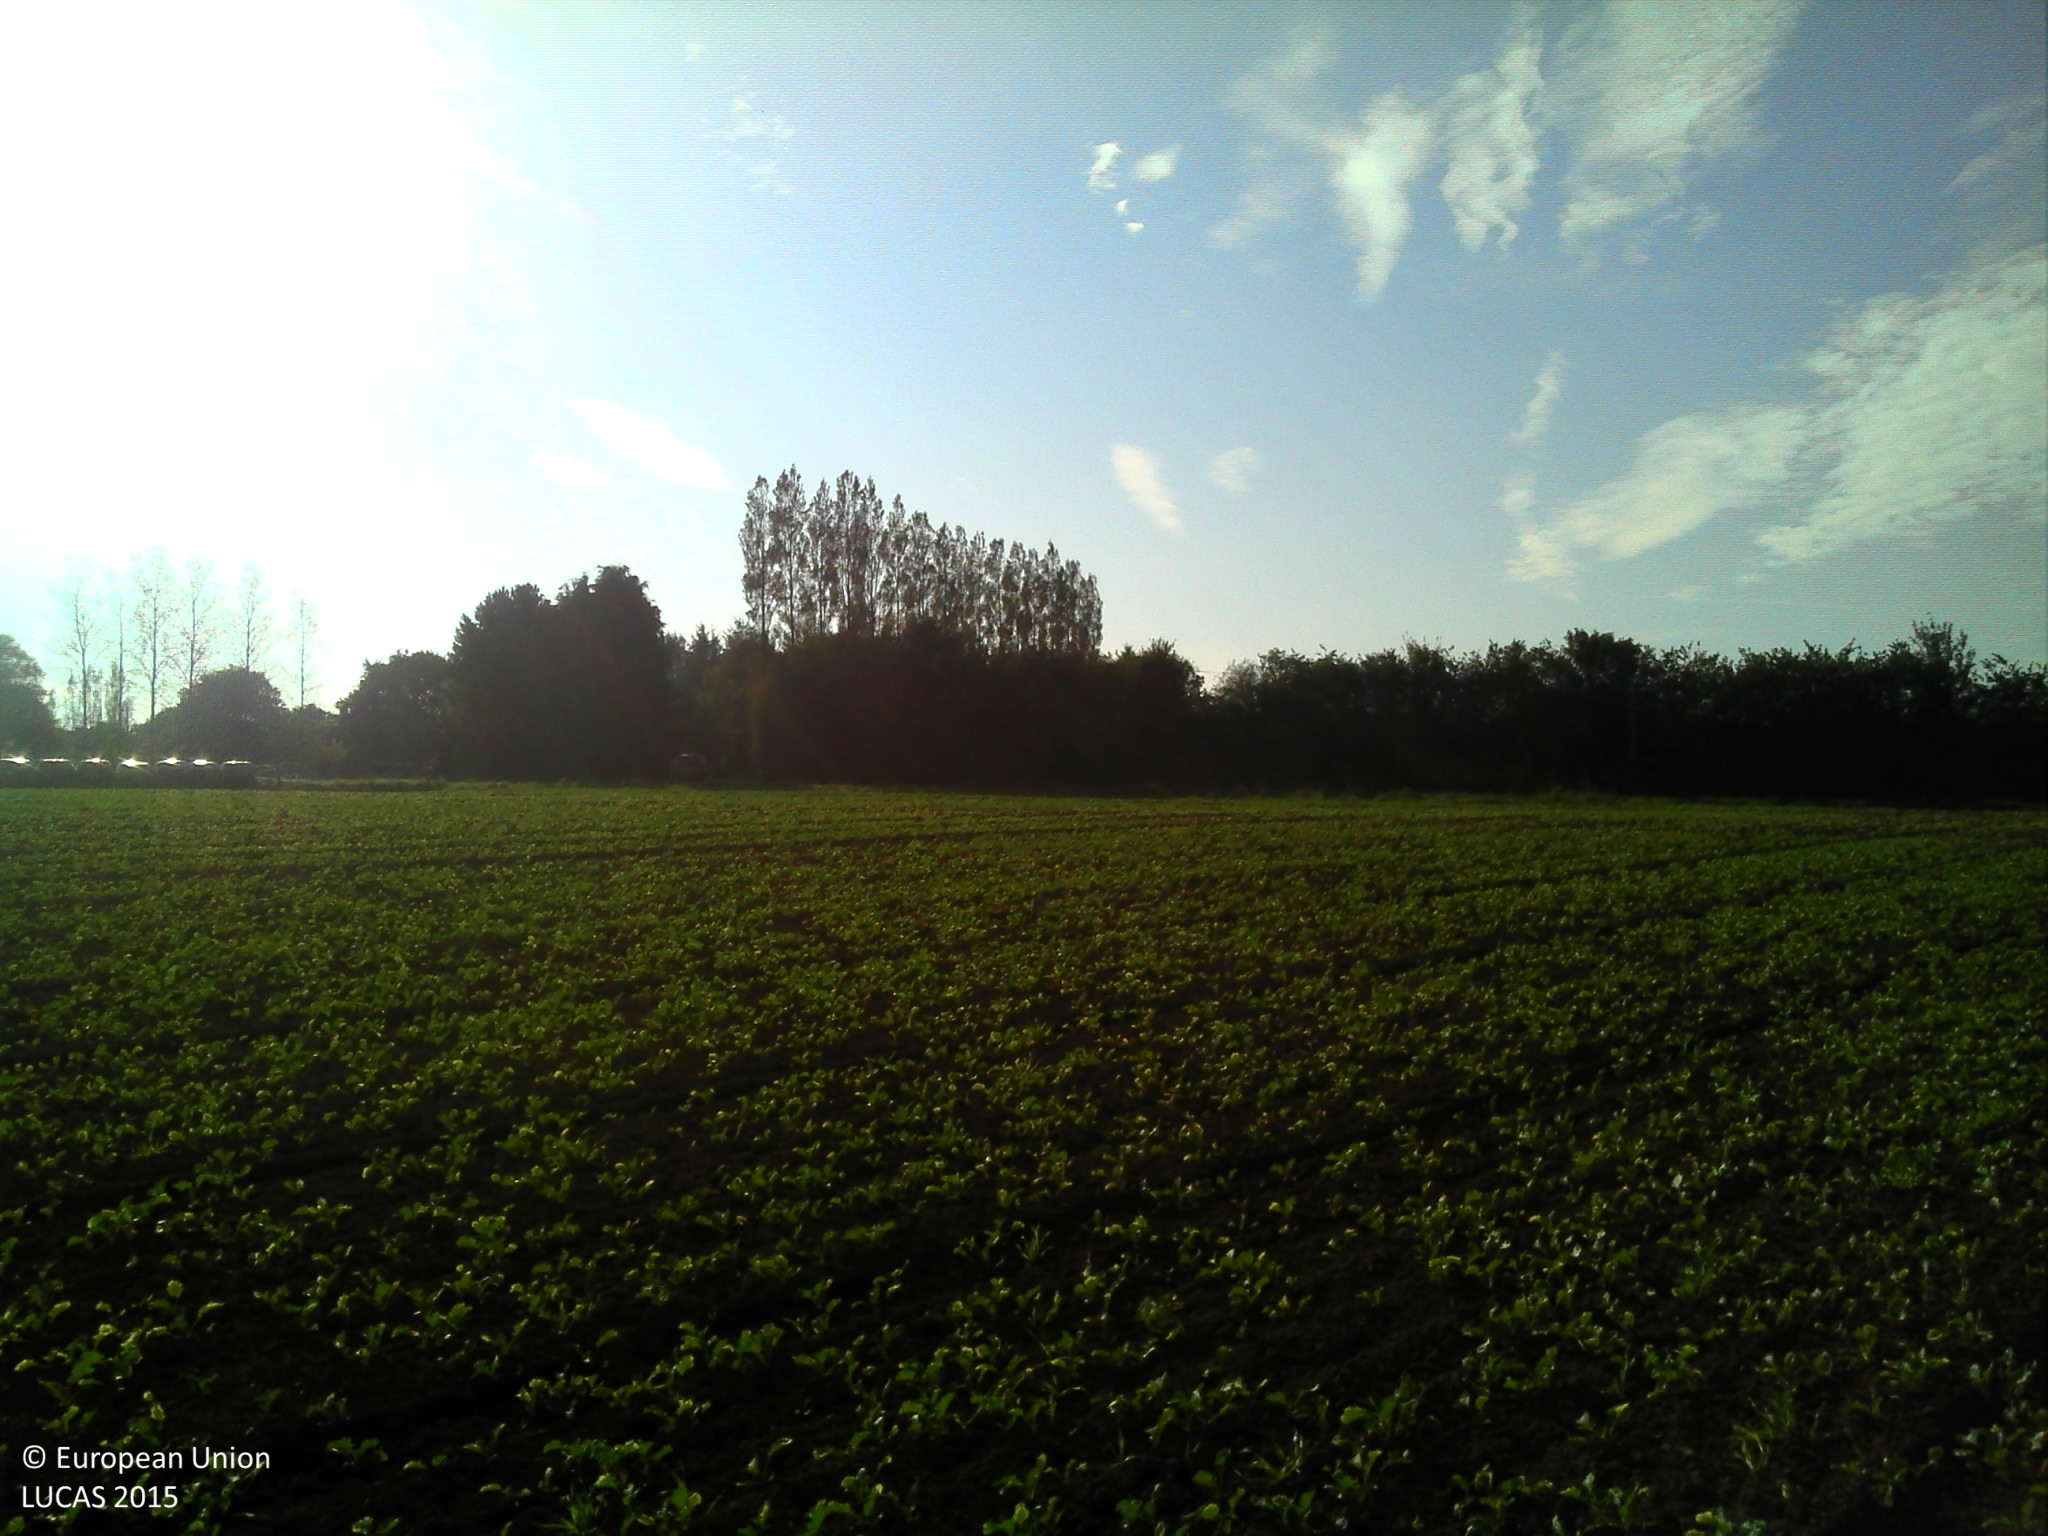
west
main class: Cropland
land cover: Rape and turnip rape
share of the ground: 25 - 50 %
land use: Agriculture (excluding fallow land and kitchen gardens)
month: October
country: FR
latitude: 48.4817
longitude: -3.2101
